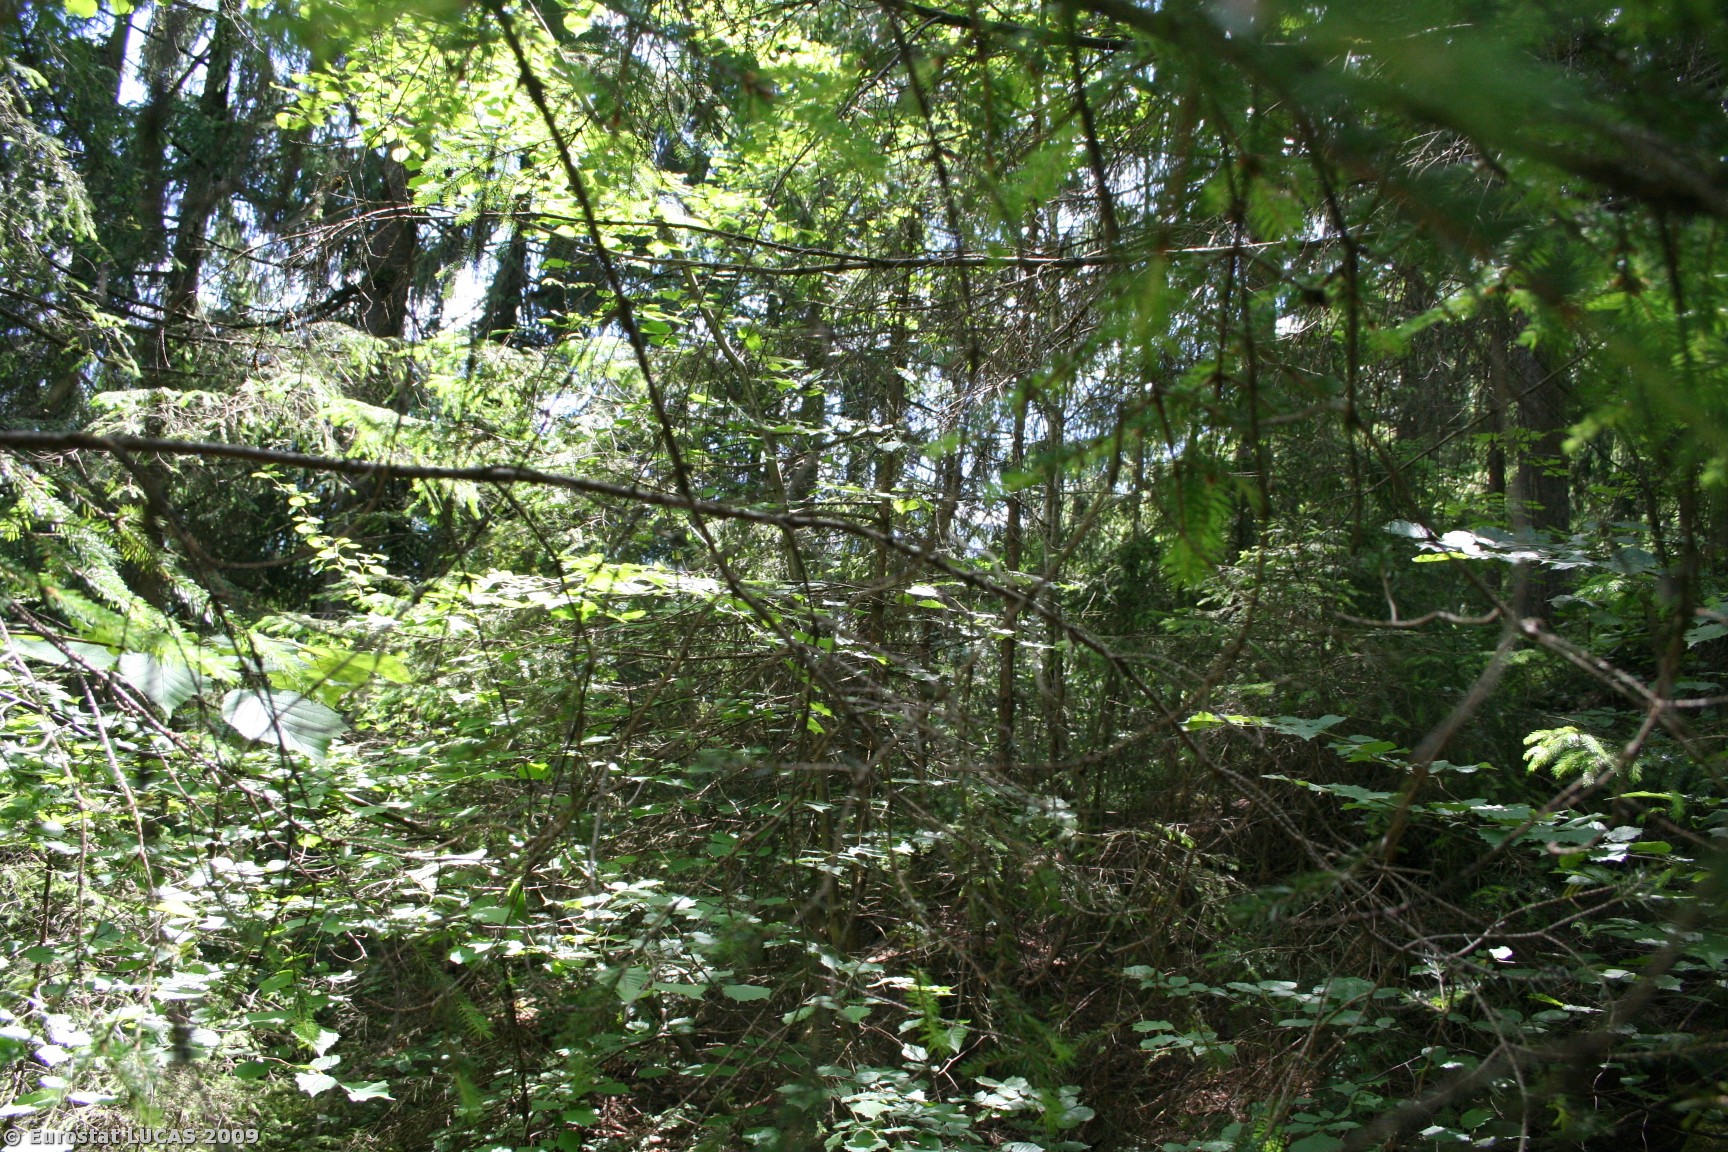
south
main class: Woodland
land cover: Coniferous woodland
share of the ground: 50 - 75 %
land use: Forestry
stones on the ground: < 10 %
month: June
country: AT
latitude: 47.2896
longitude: 11.8628
